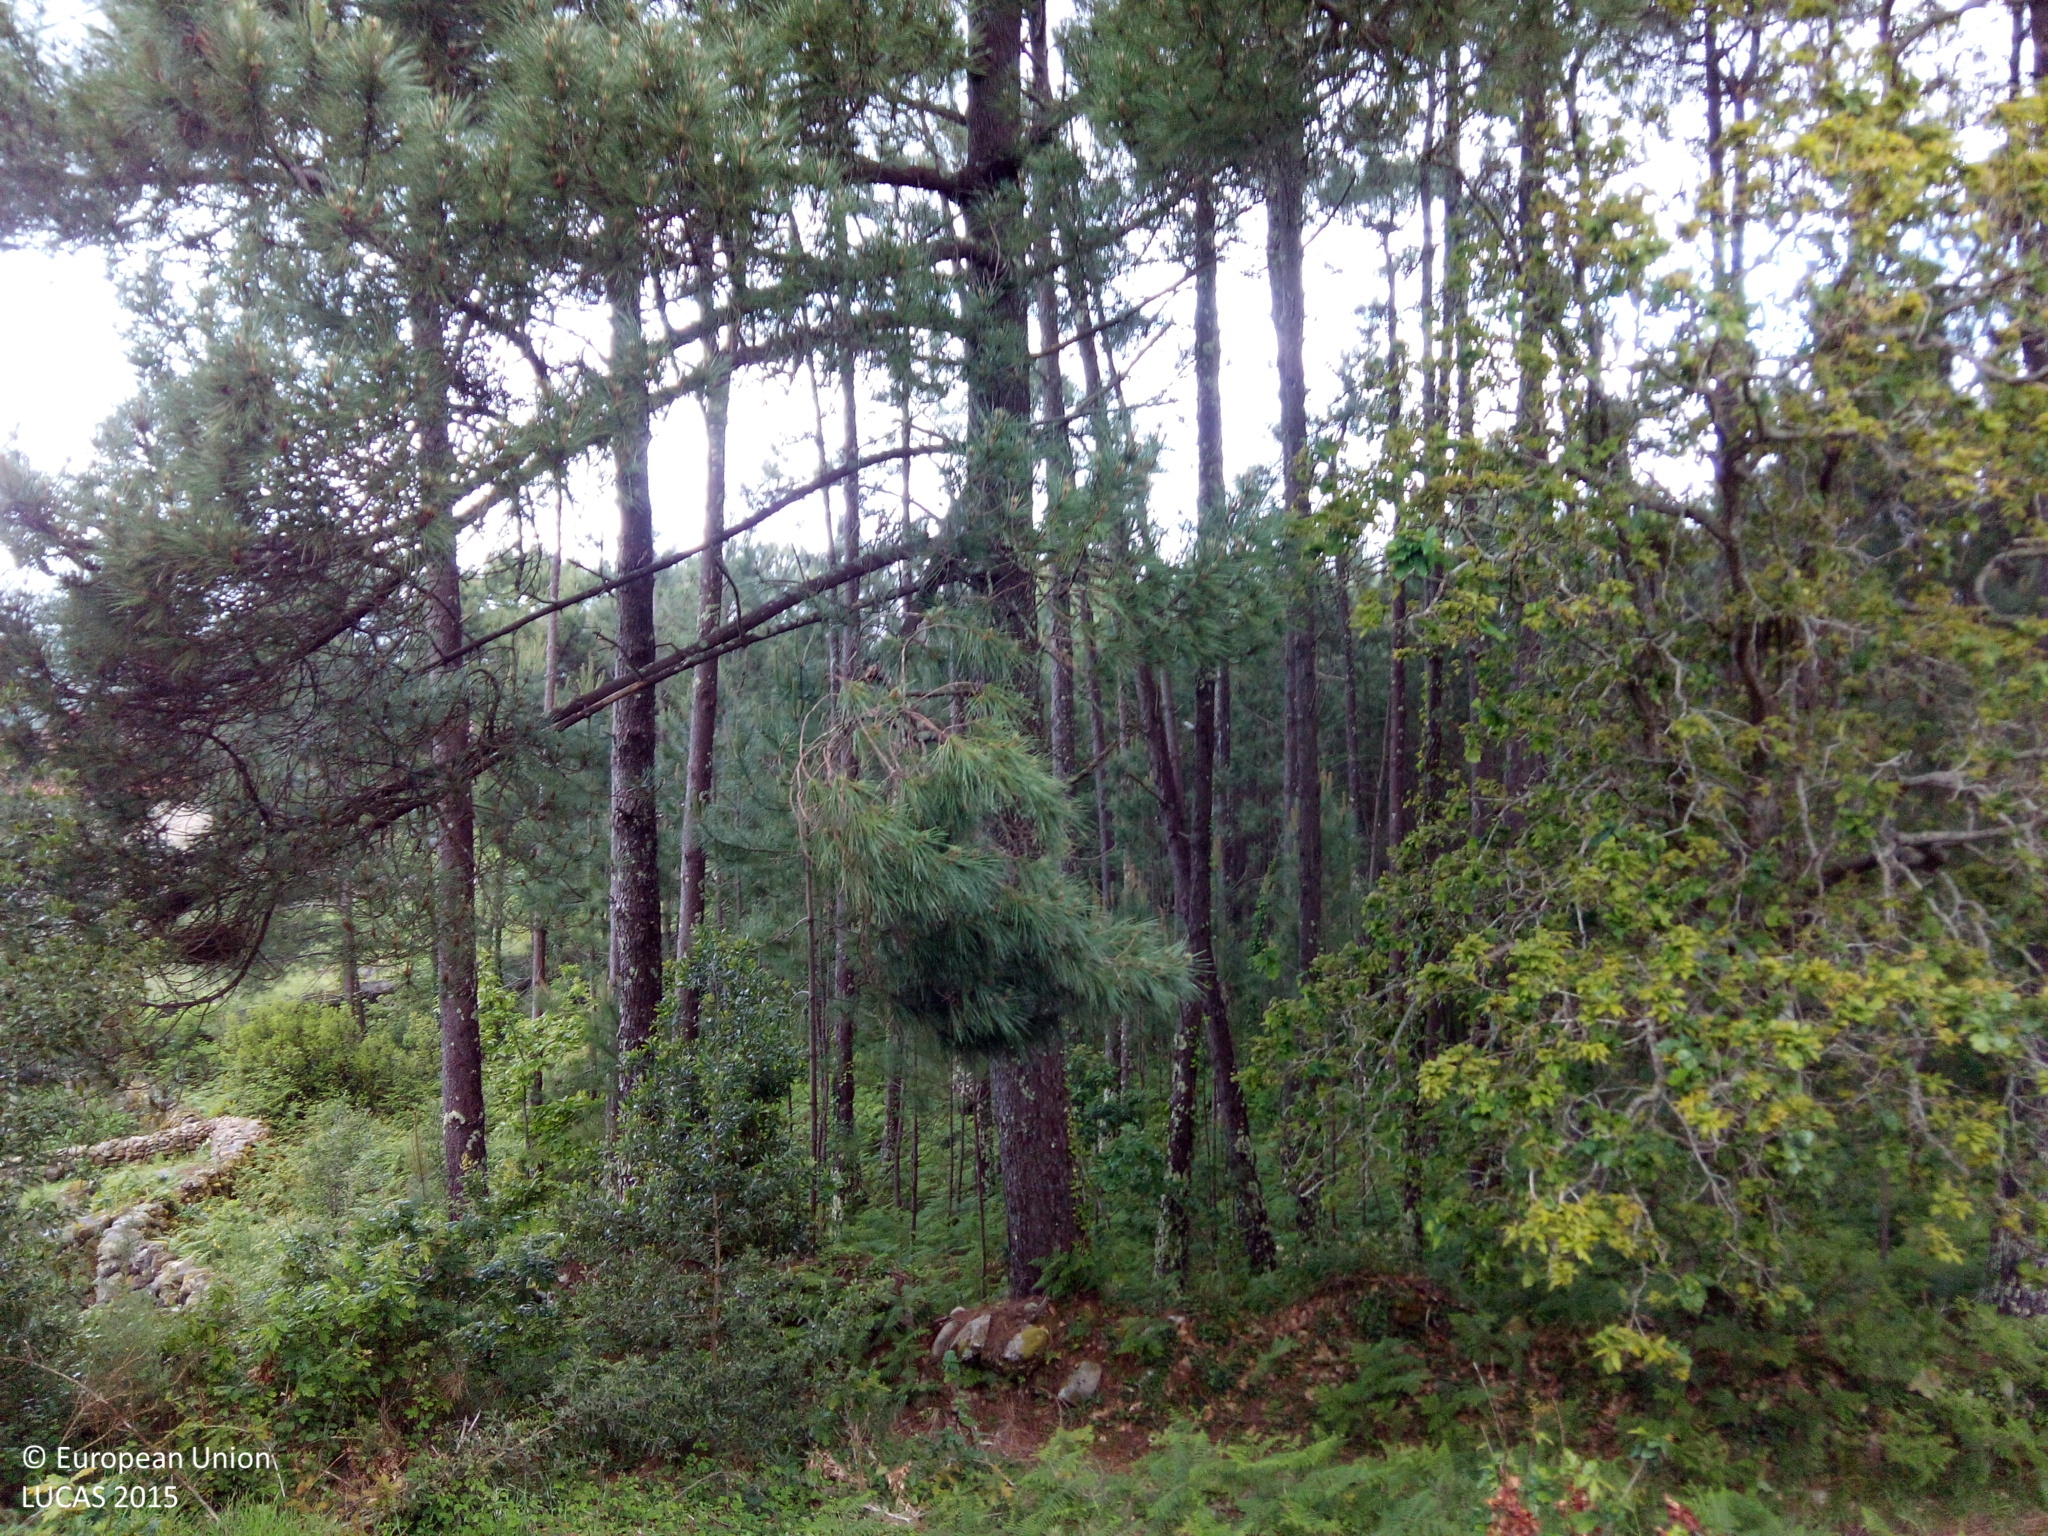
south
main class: Grassland
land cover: Grassland with sparse tree/shrub cover
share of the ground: > 75 %
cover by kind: herbaceous plants 95 %, broadleaved forest trees 5 %
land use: Residential
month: May
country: ES
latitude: 42.8165
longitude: -9.0910
